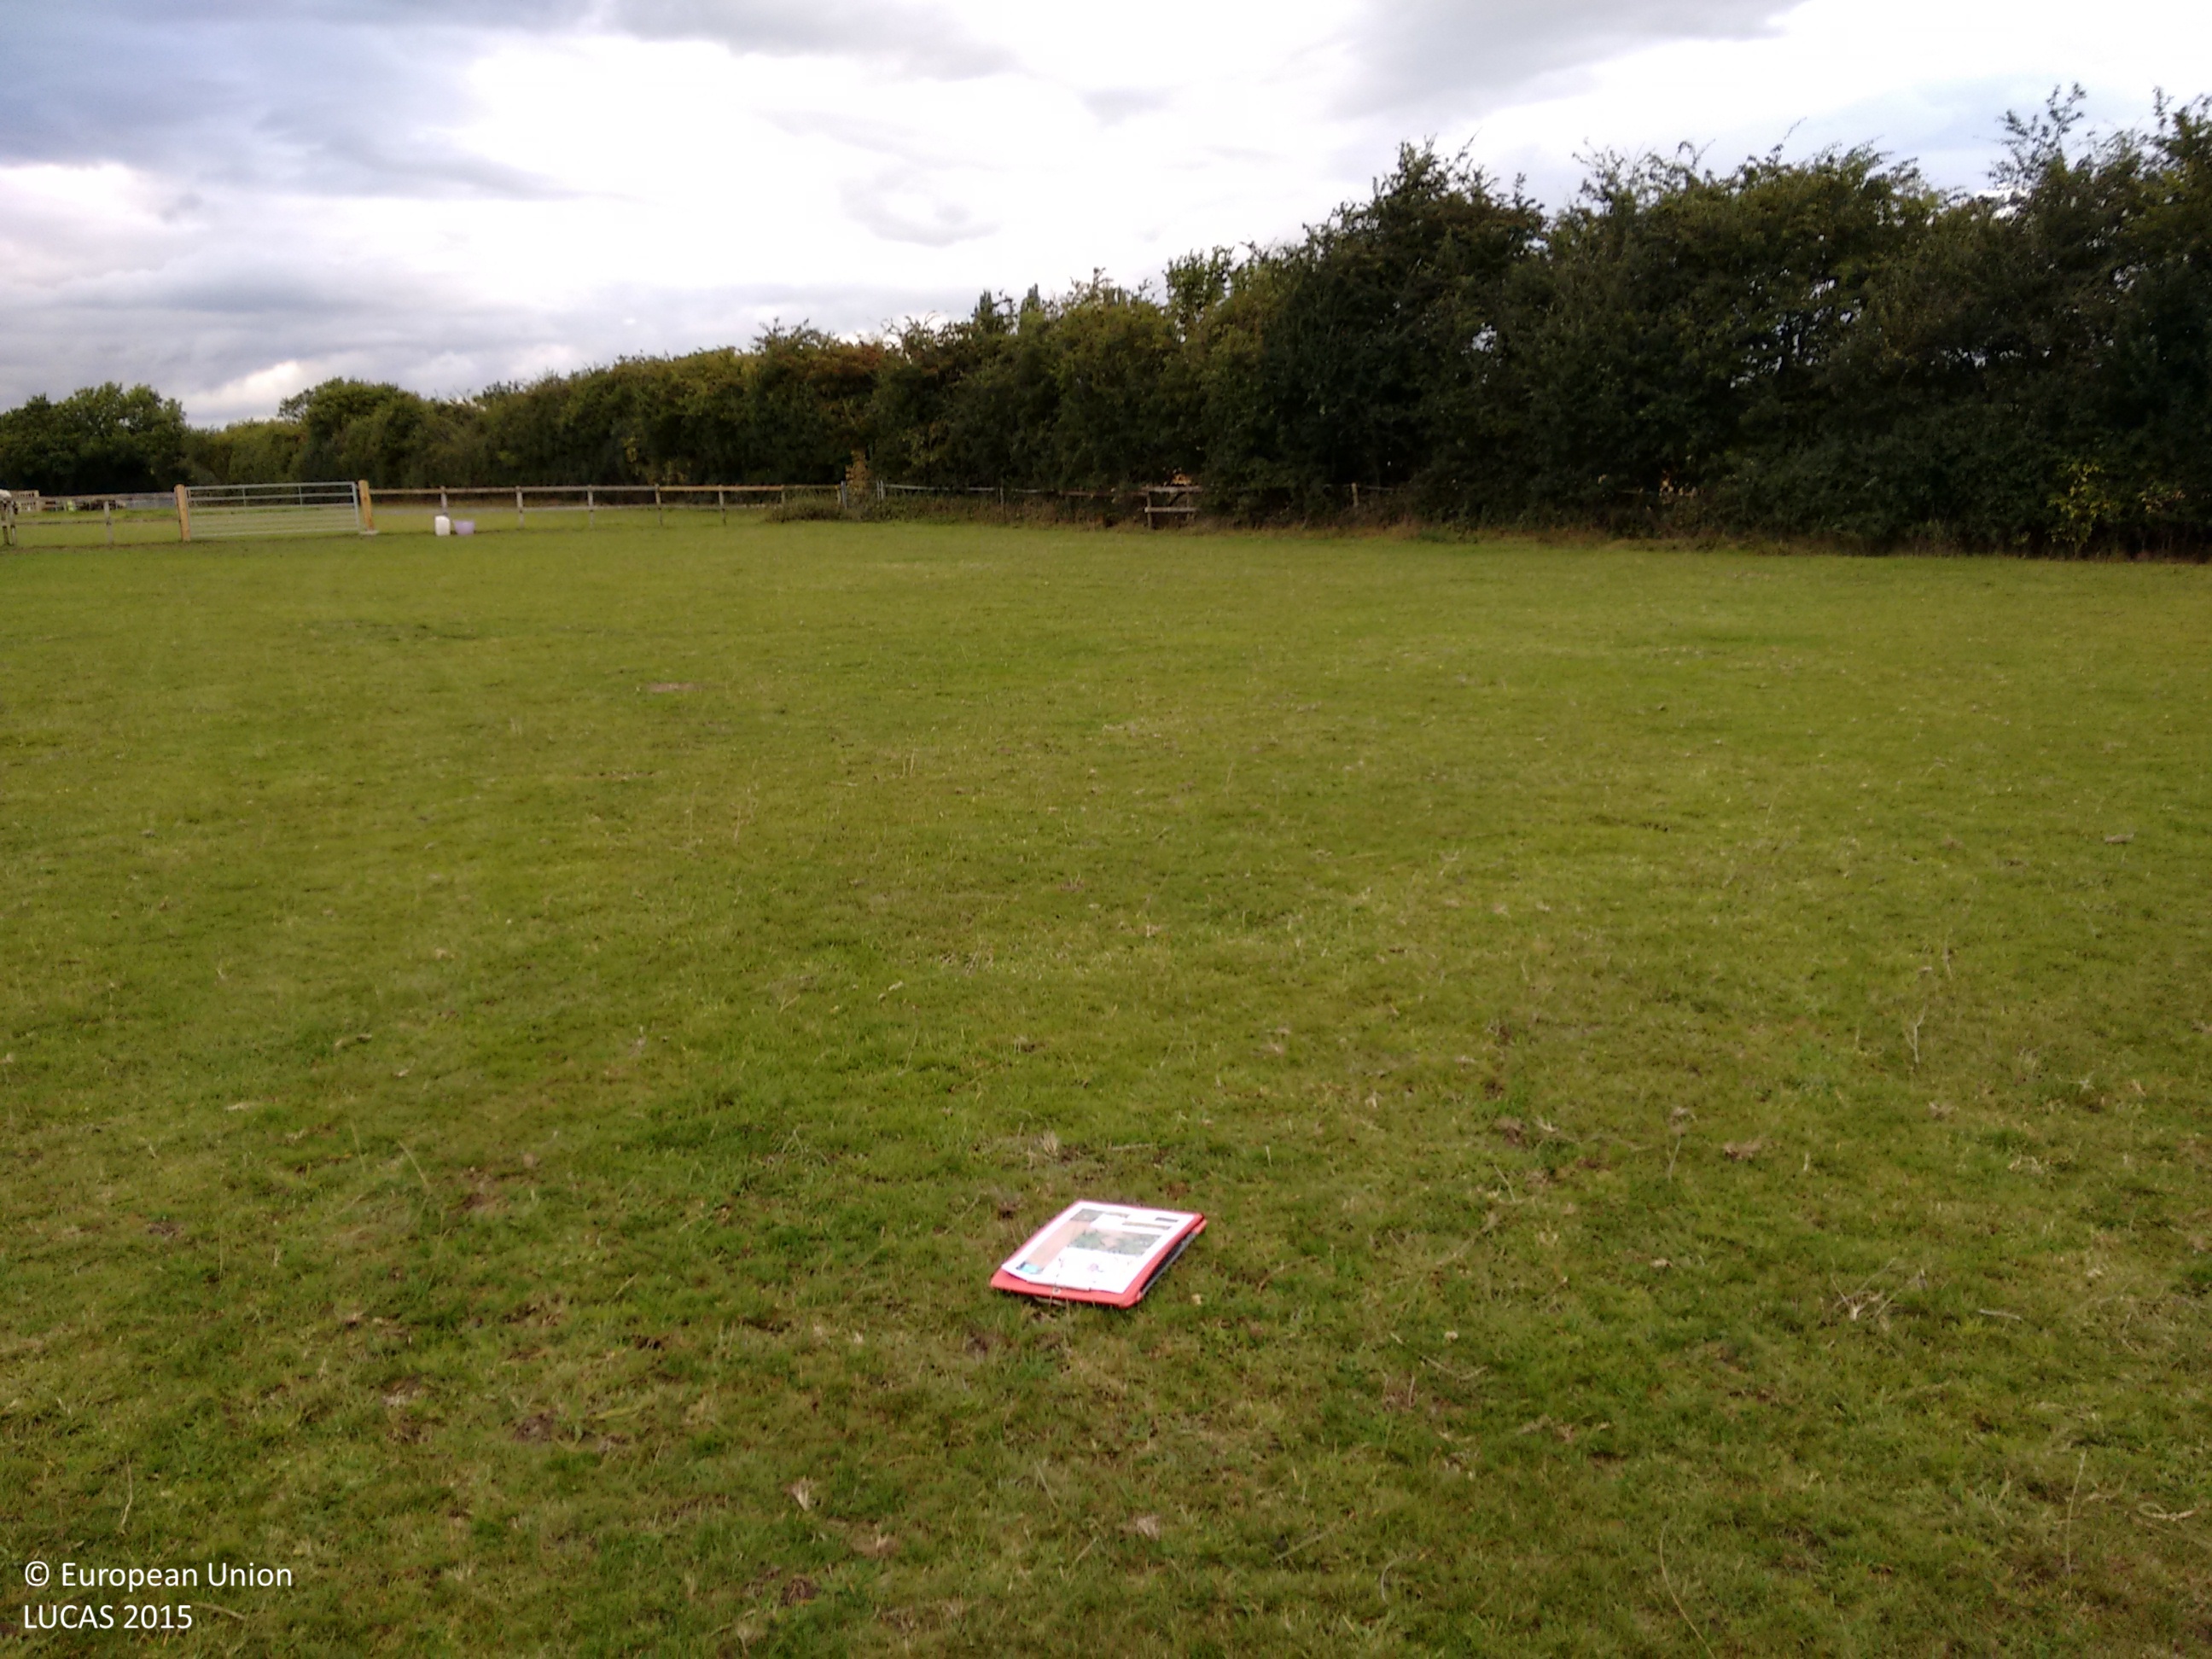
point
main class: Grassland
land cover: Grassland without tree/shrub cover
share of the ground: > 75 %
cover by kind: herbaceous plants 100 %
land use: Agriculture (excluding fallow land and kitchen gardens)
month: September
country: GB
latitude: 52.5592
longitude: -1.3328
